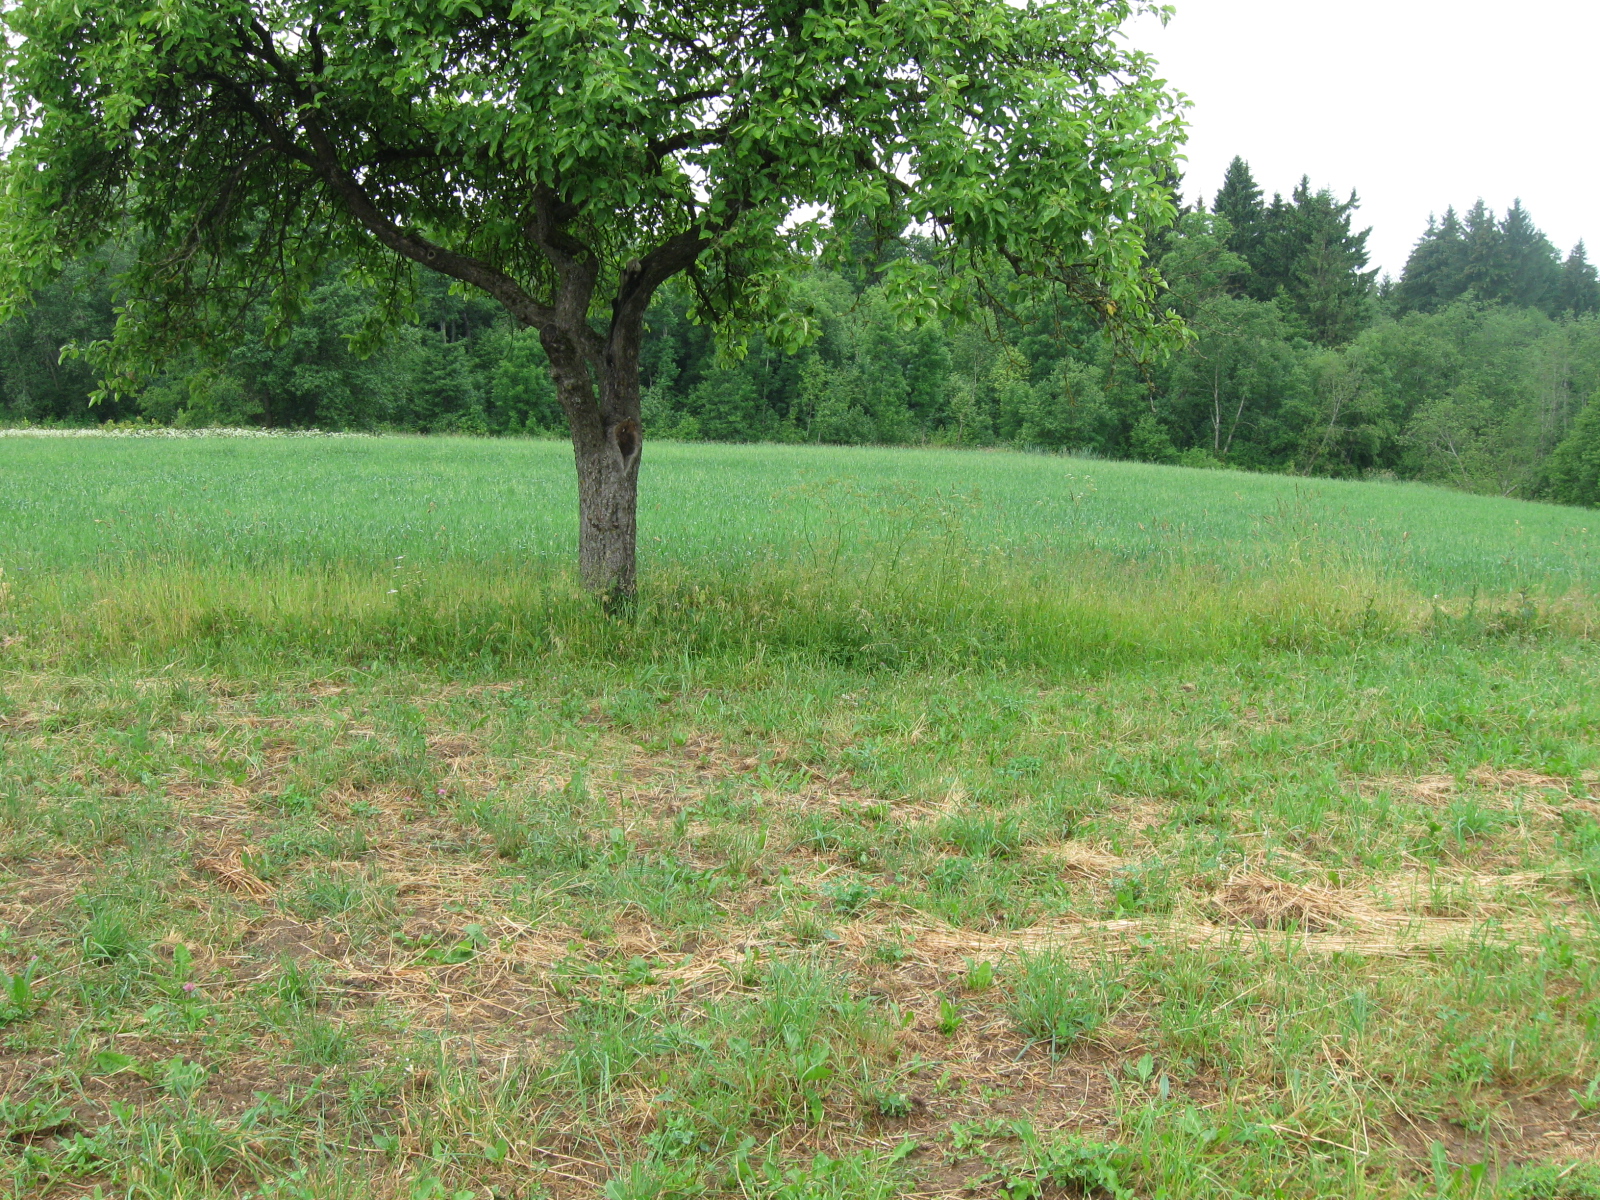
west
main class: Cropland
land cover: Apple fruit
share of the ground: < 10 %
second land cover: Grassland without tree/shrub cover
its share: > 75 %
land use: Agriculture (excluding fallow land and kitchen gardens)
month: June
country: LT
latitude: 54.7677
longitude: 24.3840
